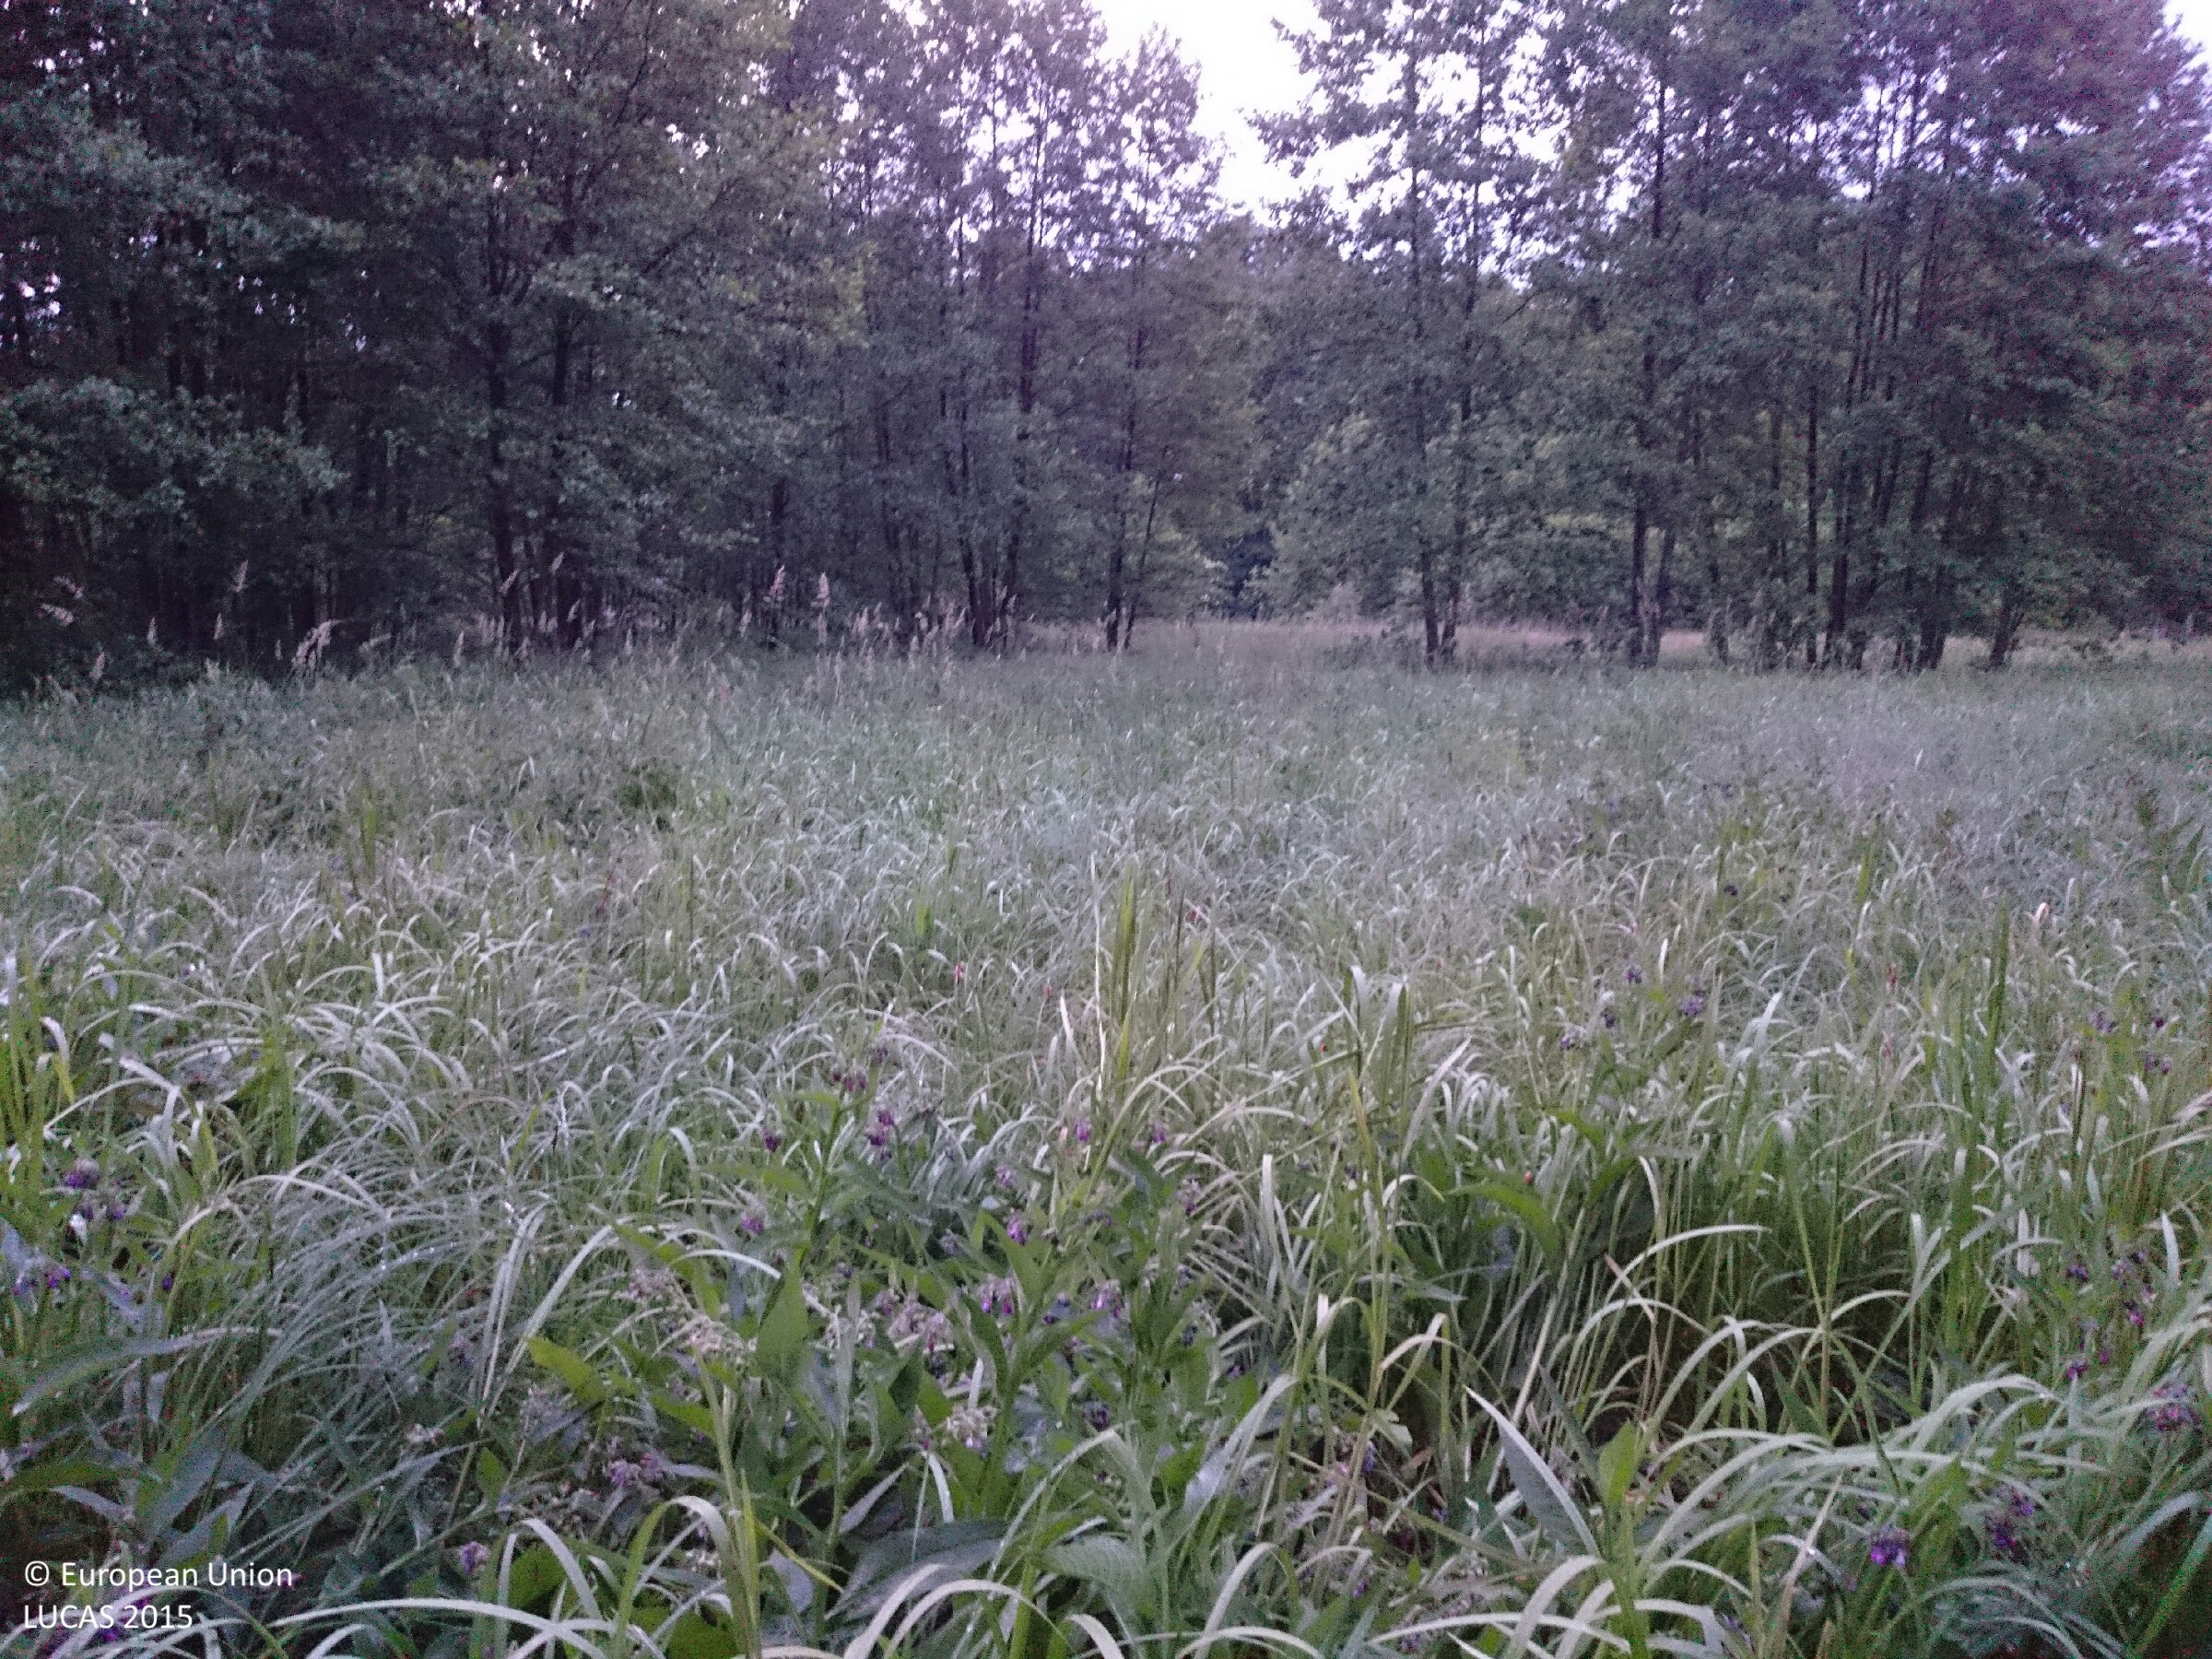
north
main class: Grassland
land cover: Grassland without tree/shrub cover
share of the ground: > 75 %
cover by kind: herbaceous plants 100 %
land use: Forestry
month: June
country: PL
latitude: 52.7641
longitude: 15.6803
